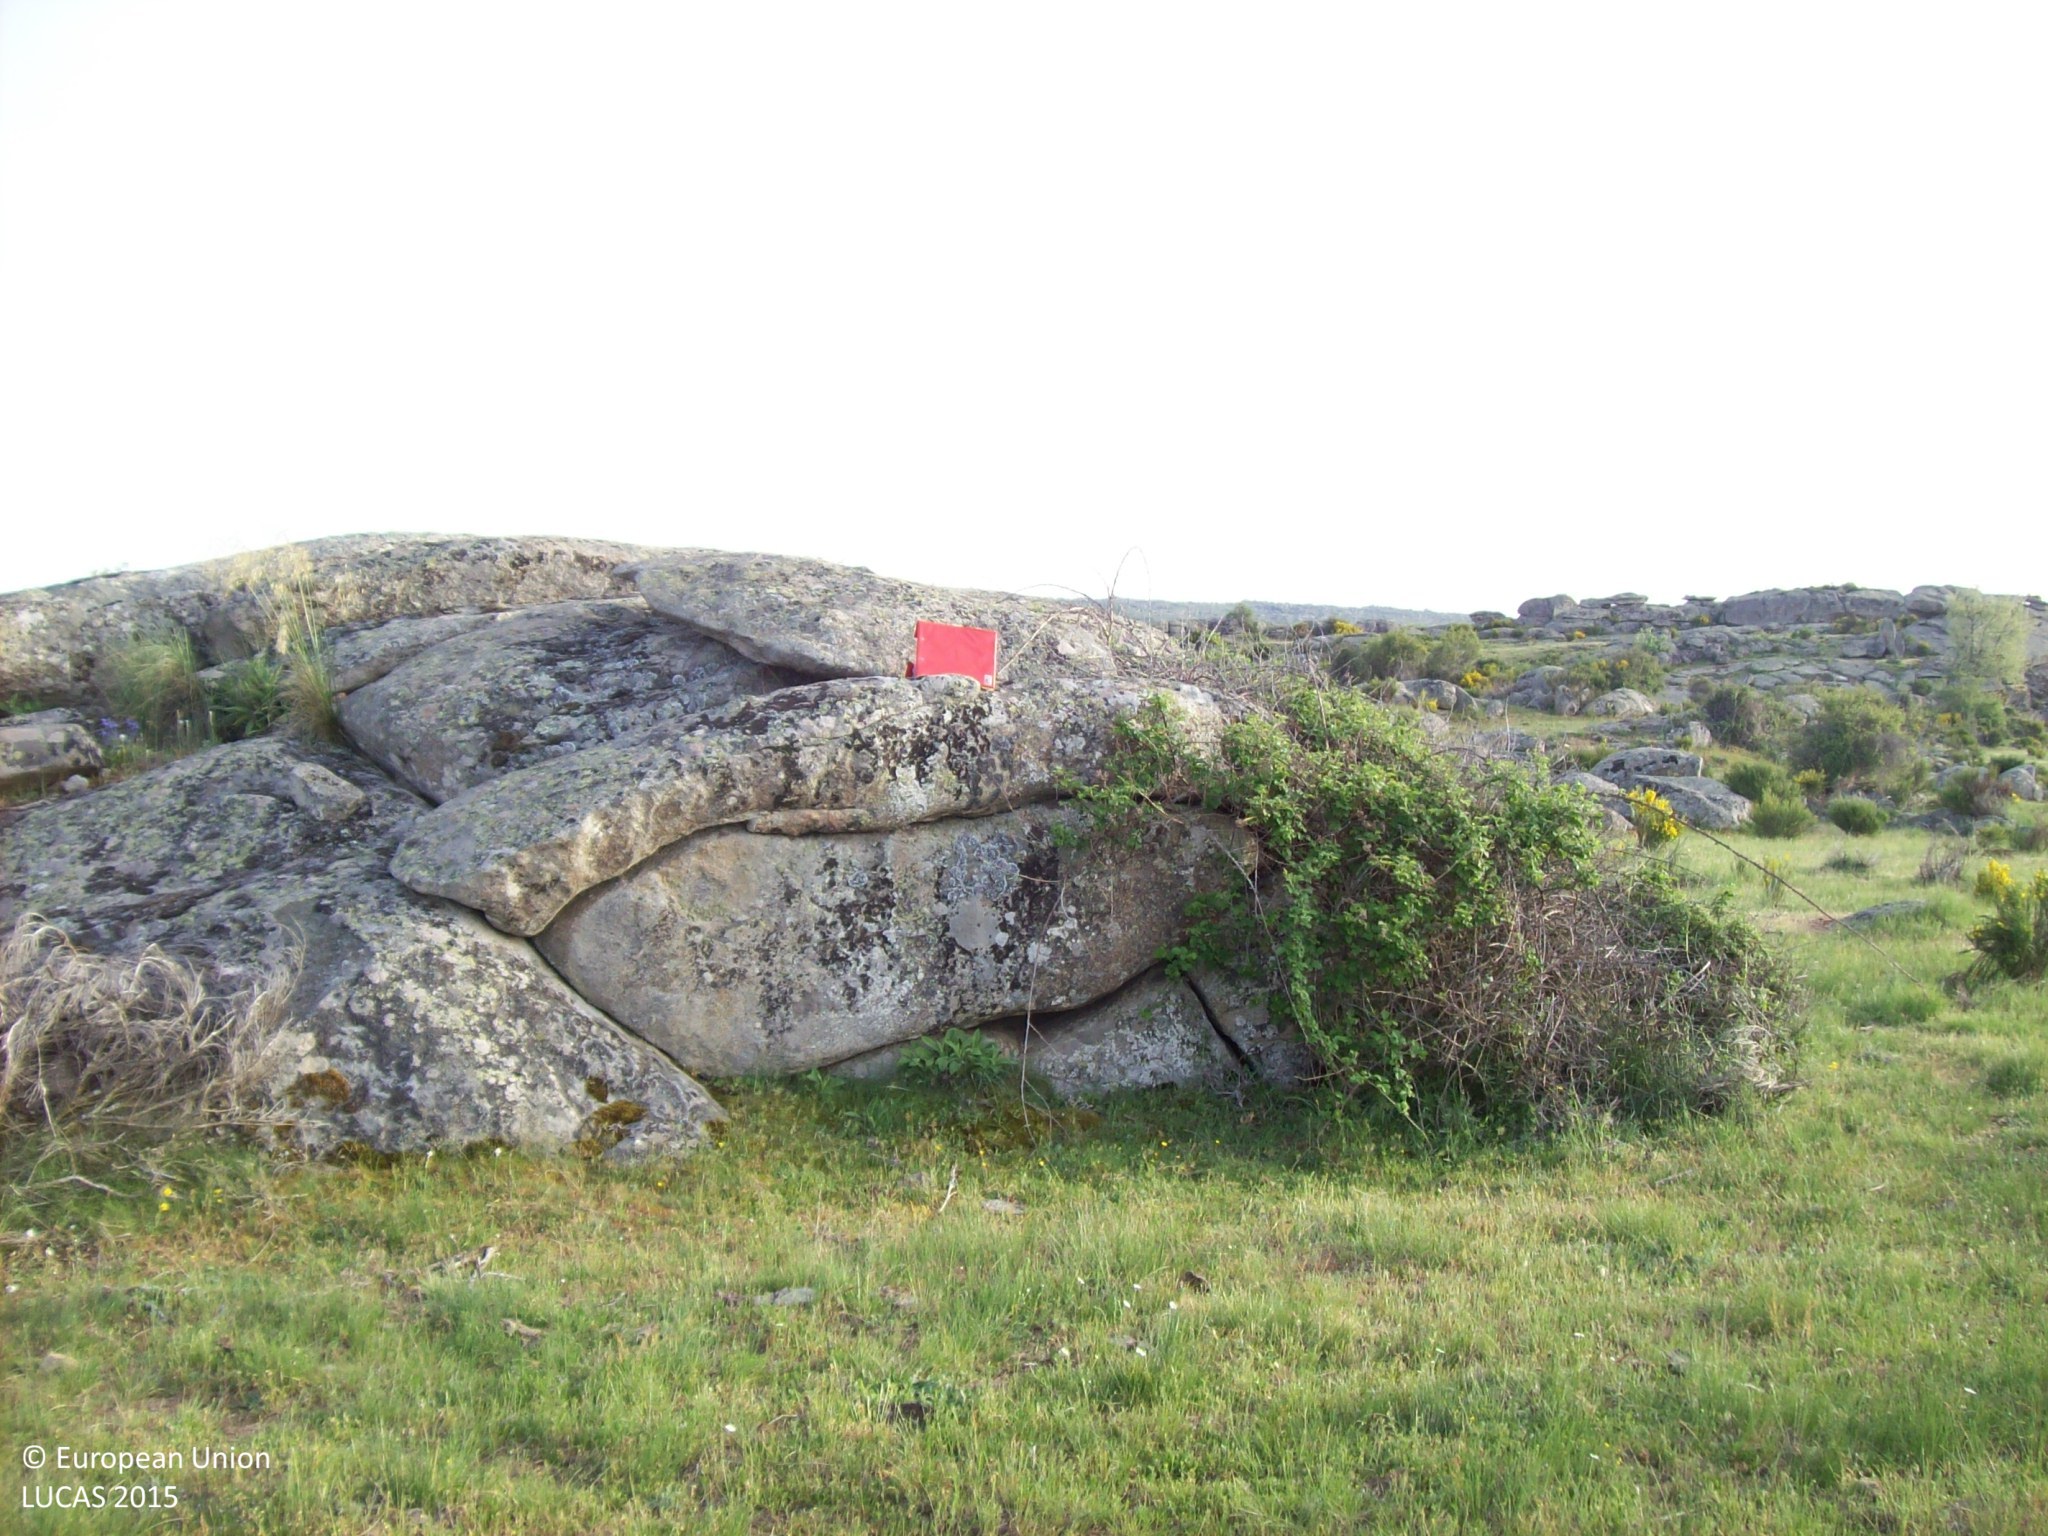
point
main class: Shrubland
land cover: Shrubland without tree cover
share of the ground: 10 - 25 %
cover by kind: consolidated bare surface 40 %, herbaceous plants 35 %, shrubs 20 %
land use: Agriculture (excluding fallow land and kitchen gardens)
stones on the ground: < 10 %
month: May
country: ES
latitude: 40.6992
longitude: -4.9124
